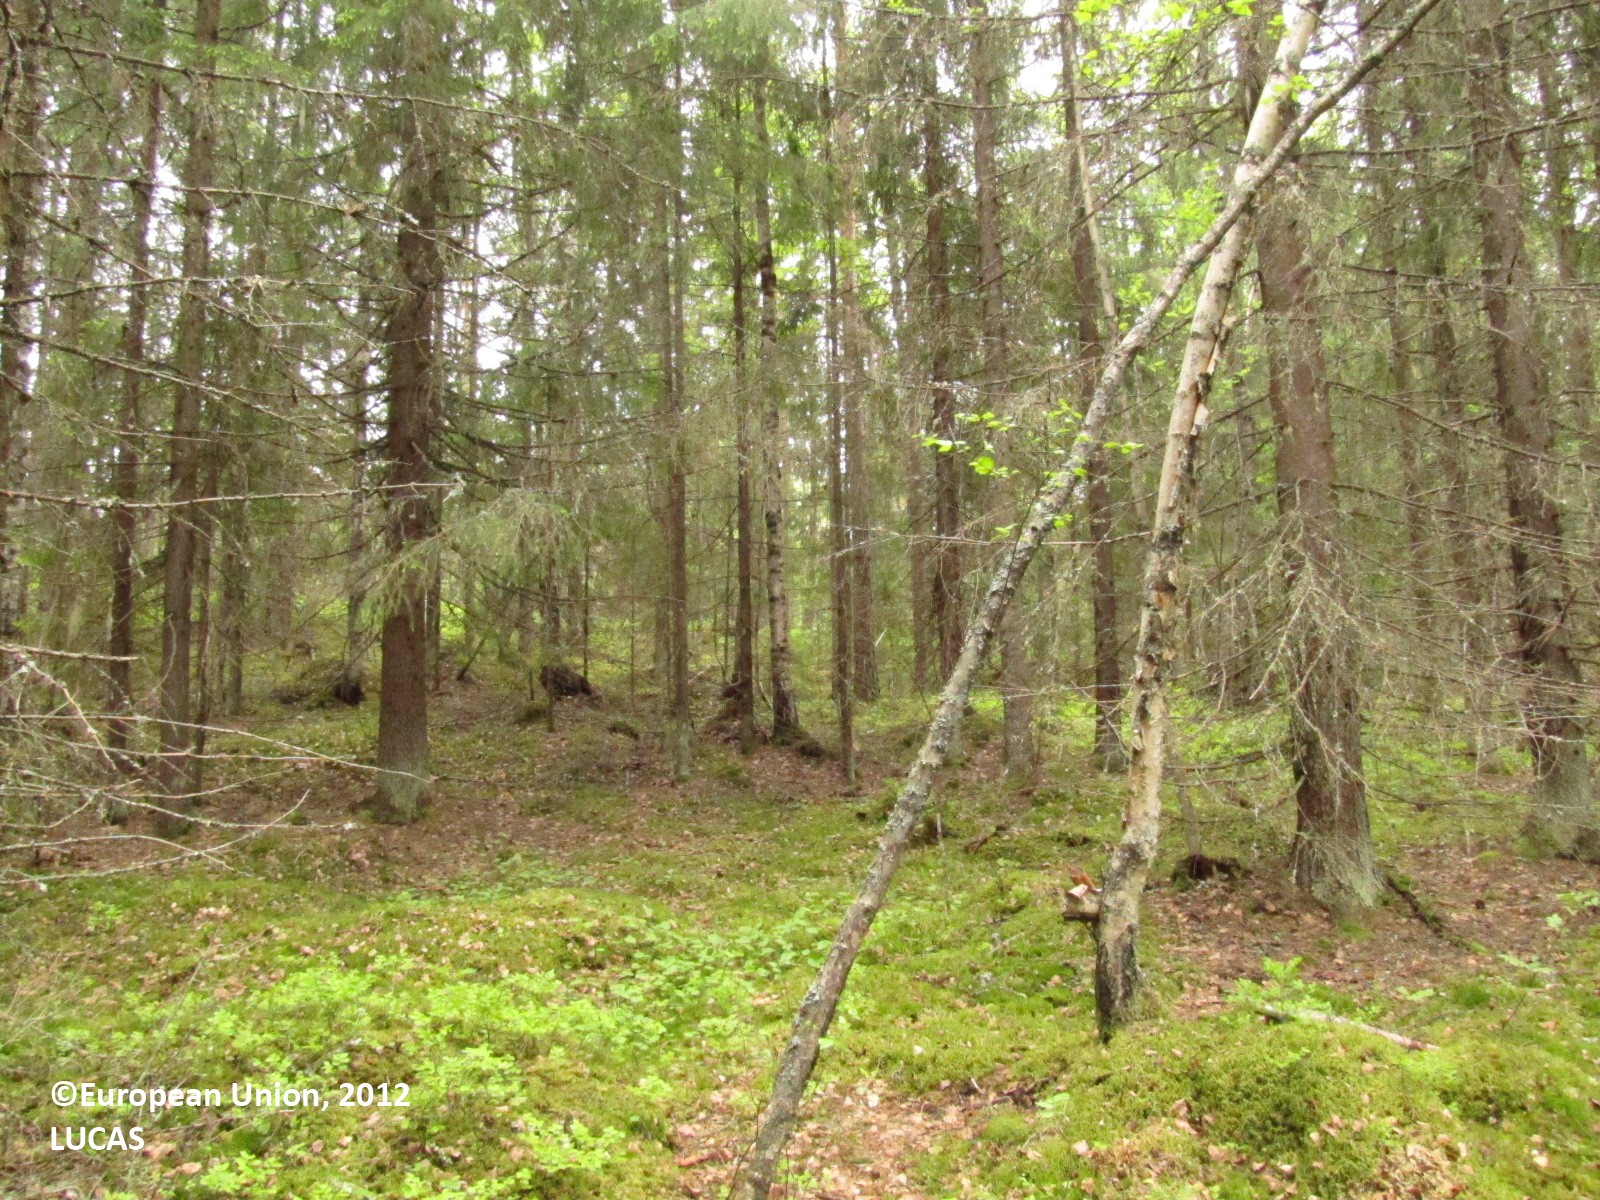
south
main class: Woodland
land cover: Spruce dominated mixed woodland
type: hemiboreal forest and nemoral coniferous forest and mixed broadleaved-coniferous forest
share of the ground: 50 - 75 %
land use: Forestry
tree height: > 5 m
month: June
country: FI
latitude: 61.4886
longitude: 23.0870
